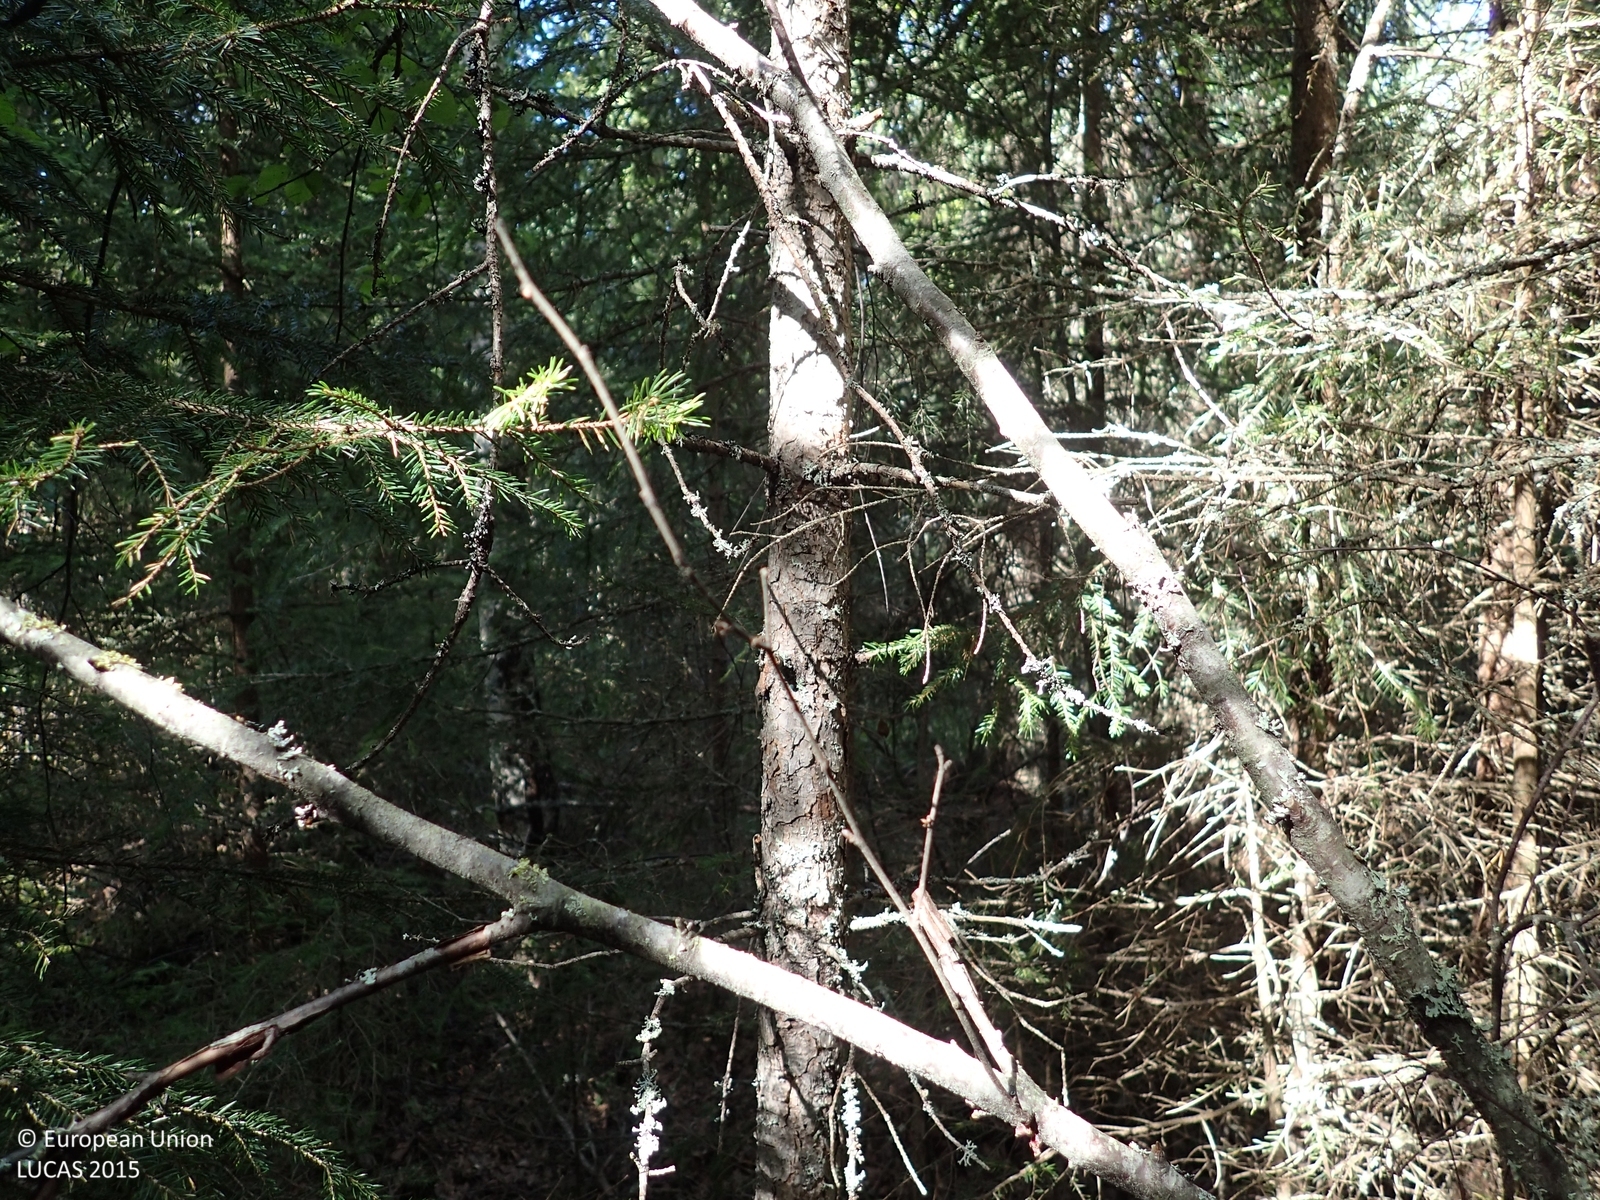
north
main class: Woodland
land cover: Other mixed woodland
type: boreal forest
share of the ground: > 75 %
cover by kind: coniferous forest trees 60 %, broadleaved forest trees 25 %, shrubs 10 %, lichens and mosses 5 %
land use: Forestry
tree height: > 5 m
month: August
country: FI
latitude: 62.2809
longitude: 23.0350
